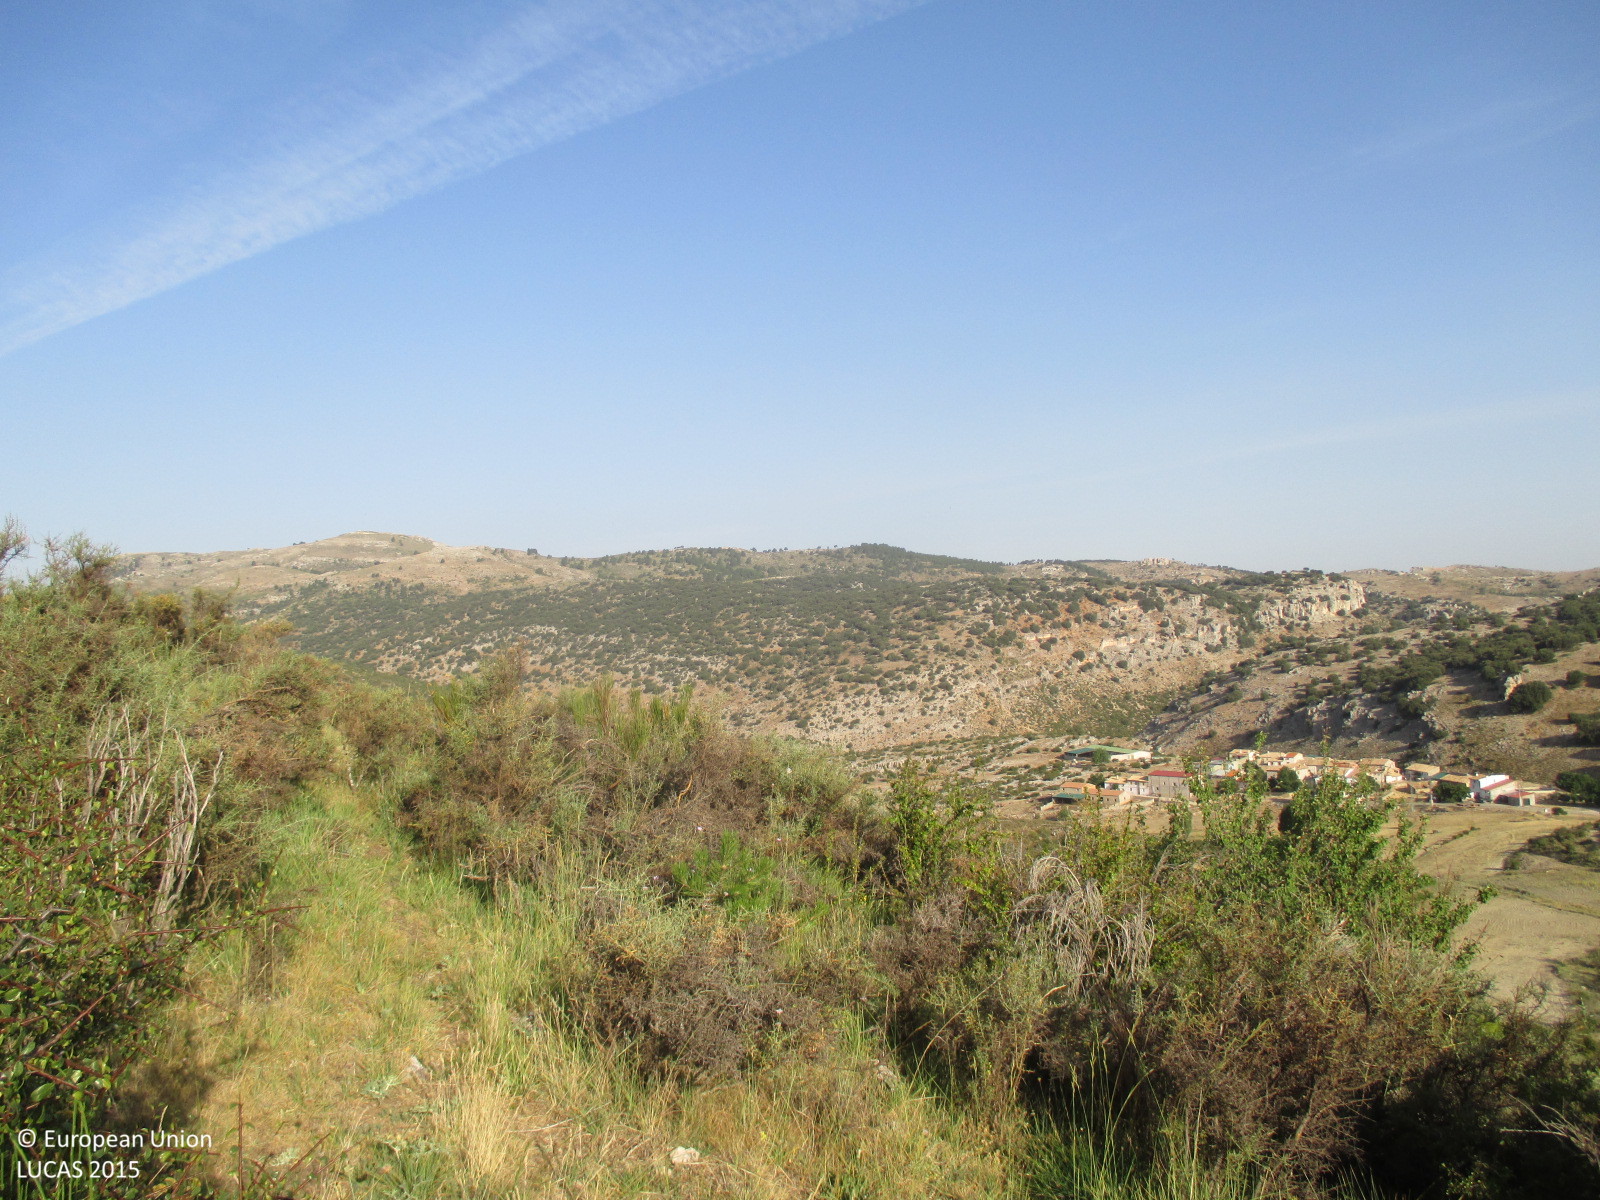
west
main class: Shrubland
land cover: Shrubland without tree cover
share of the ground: > 75 %
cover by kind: shrubs 90 %, herbaceous plants 10 %
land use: Semi-natural and natural areas not in use
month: July
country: ES
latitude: 38.0856
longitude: -2.4087
